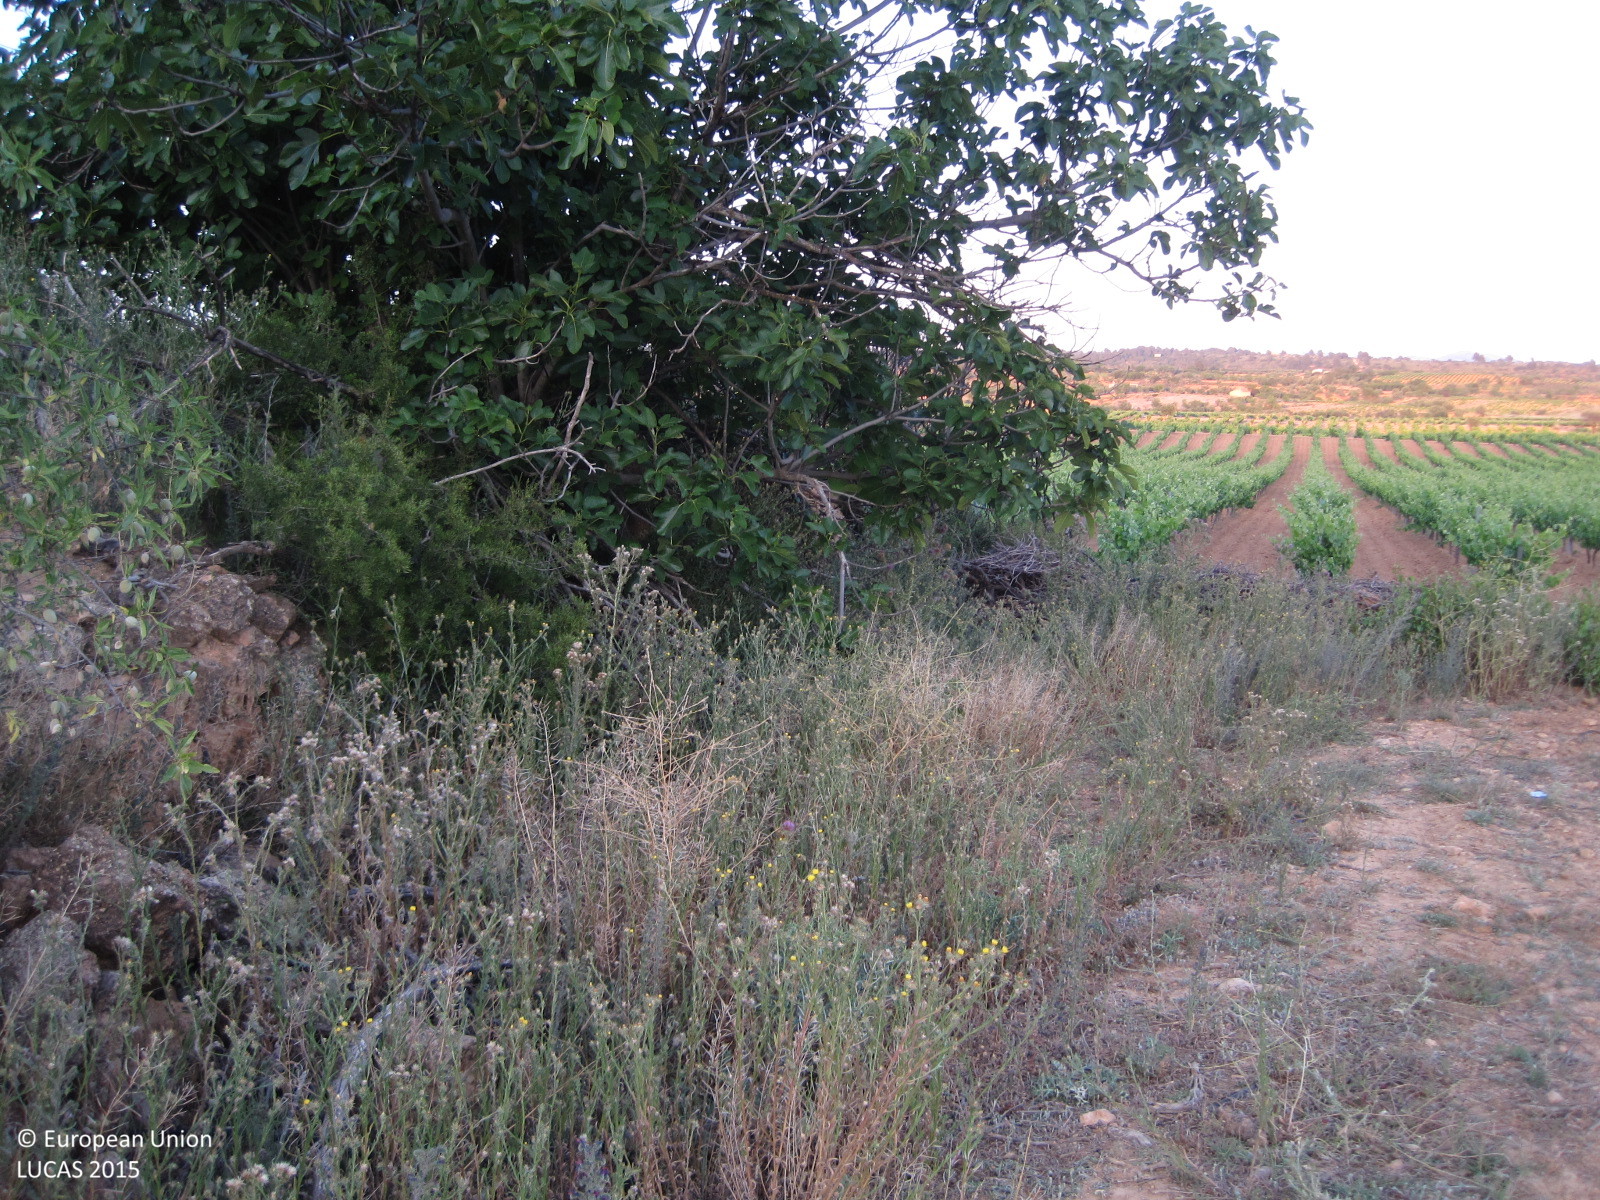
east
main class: Cropland
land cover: Vineyards
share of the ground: 25 - 50 %
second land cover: Other bare soil
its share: > 75 %
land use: Agriculture (excluding fallow land and kitchen gardens)
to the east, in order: Vineyards; Other bare soil; Shrubland with sparse tree cover; Dry stone walls; Shruby margins; Other bare soil; Vineyards; Other bare soil; Vineyards
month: May
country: ES
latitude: 39.5425
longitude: -1.1144
